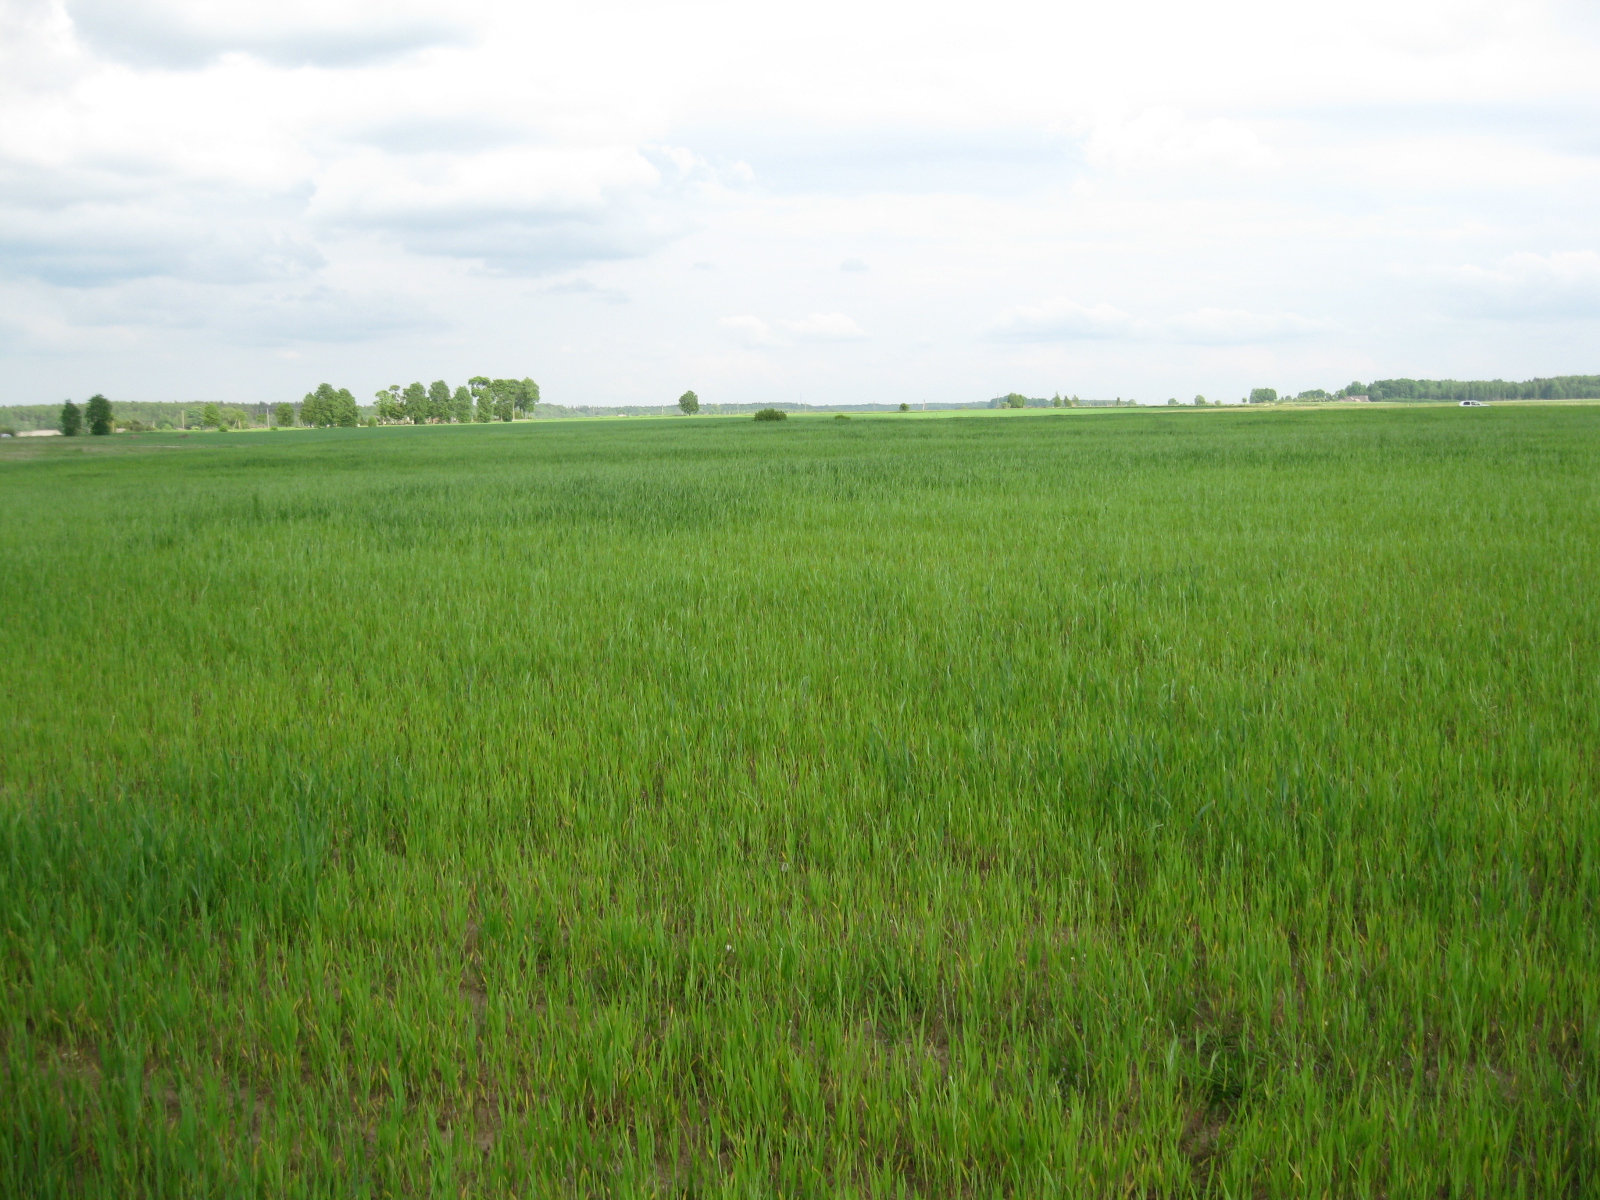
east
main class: Cropland
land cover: Common wheat
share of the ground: > 75 %
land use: Agriculture (excluding fallow land and kitchen gardens)
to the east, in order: Common wheat; Spontaneously vegetated surfaces; Ditches and canals; Spontaneously vegetated surfaces
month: May
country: LT
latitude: 55.7291
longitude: 24.7709
